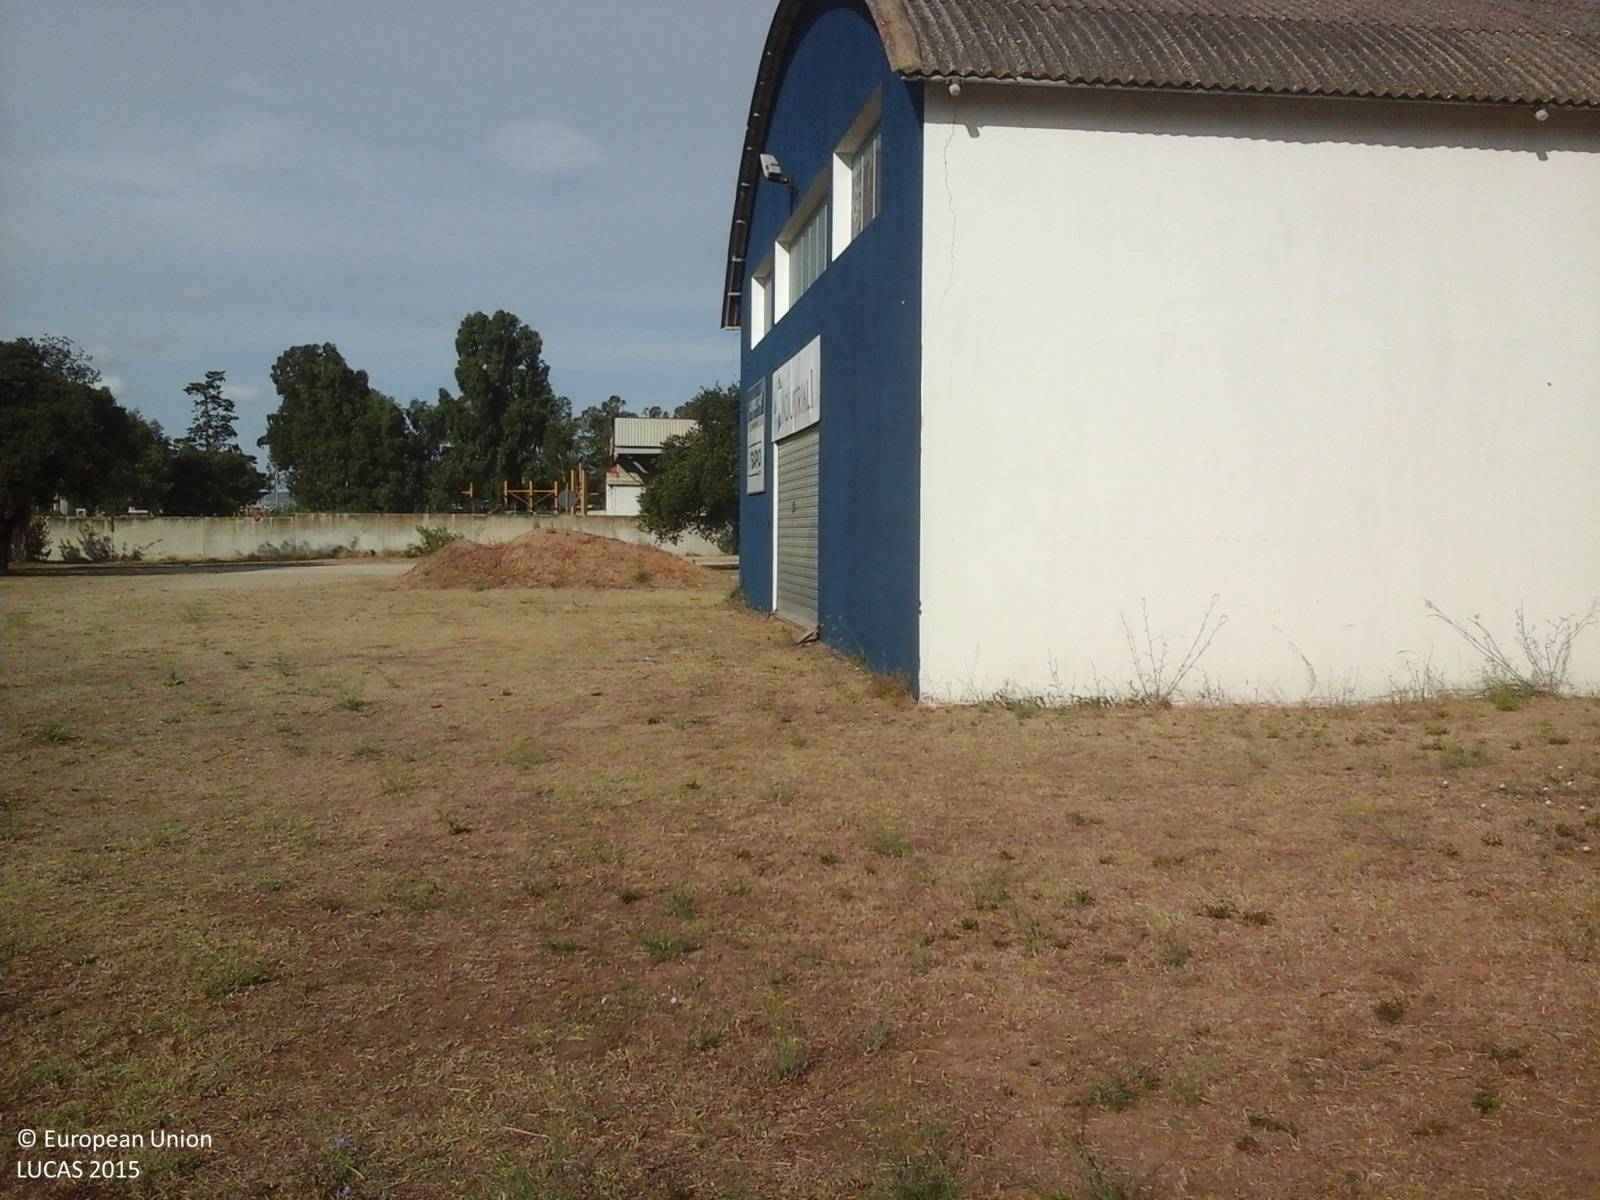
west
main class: Grassland
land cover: Grassland without tree/shrub cover
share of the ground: > 75 %
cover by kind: herbaceous plants 90 %, unconsolidated bare surface 10 %
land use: Commerce
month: August
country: IT
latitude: 40.9357
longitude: 9.5153
